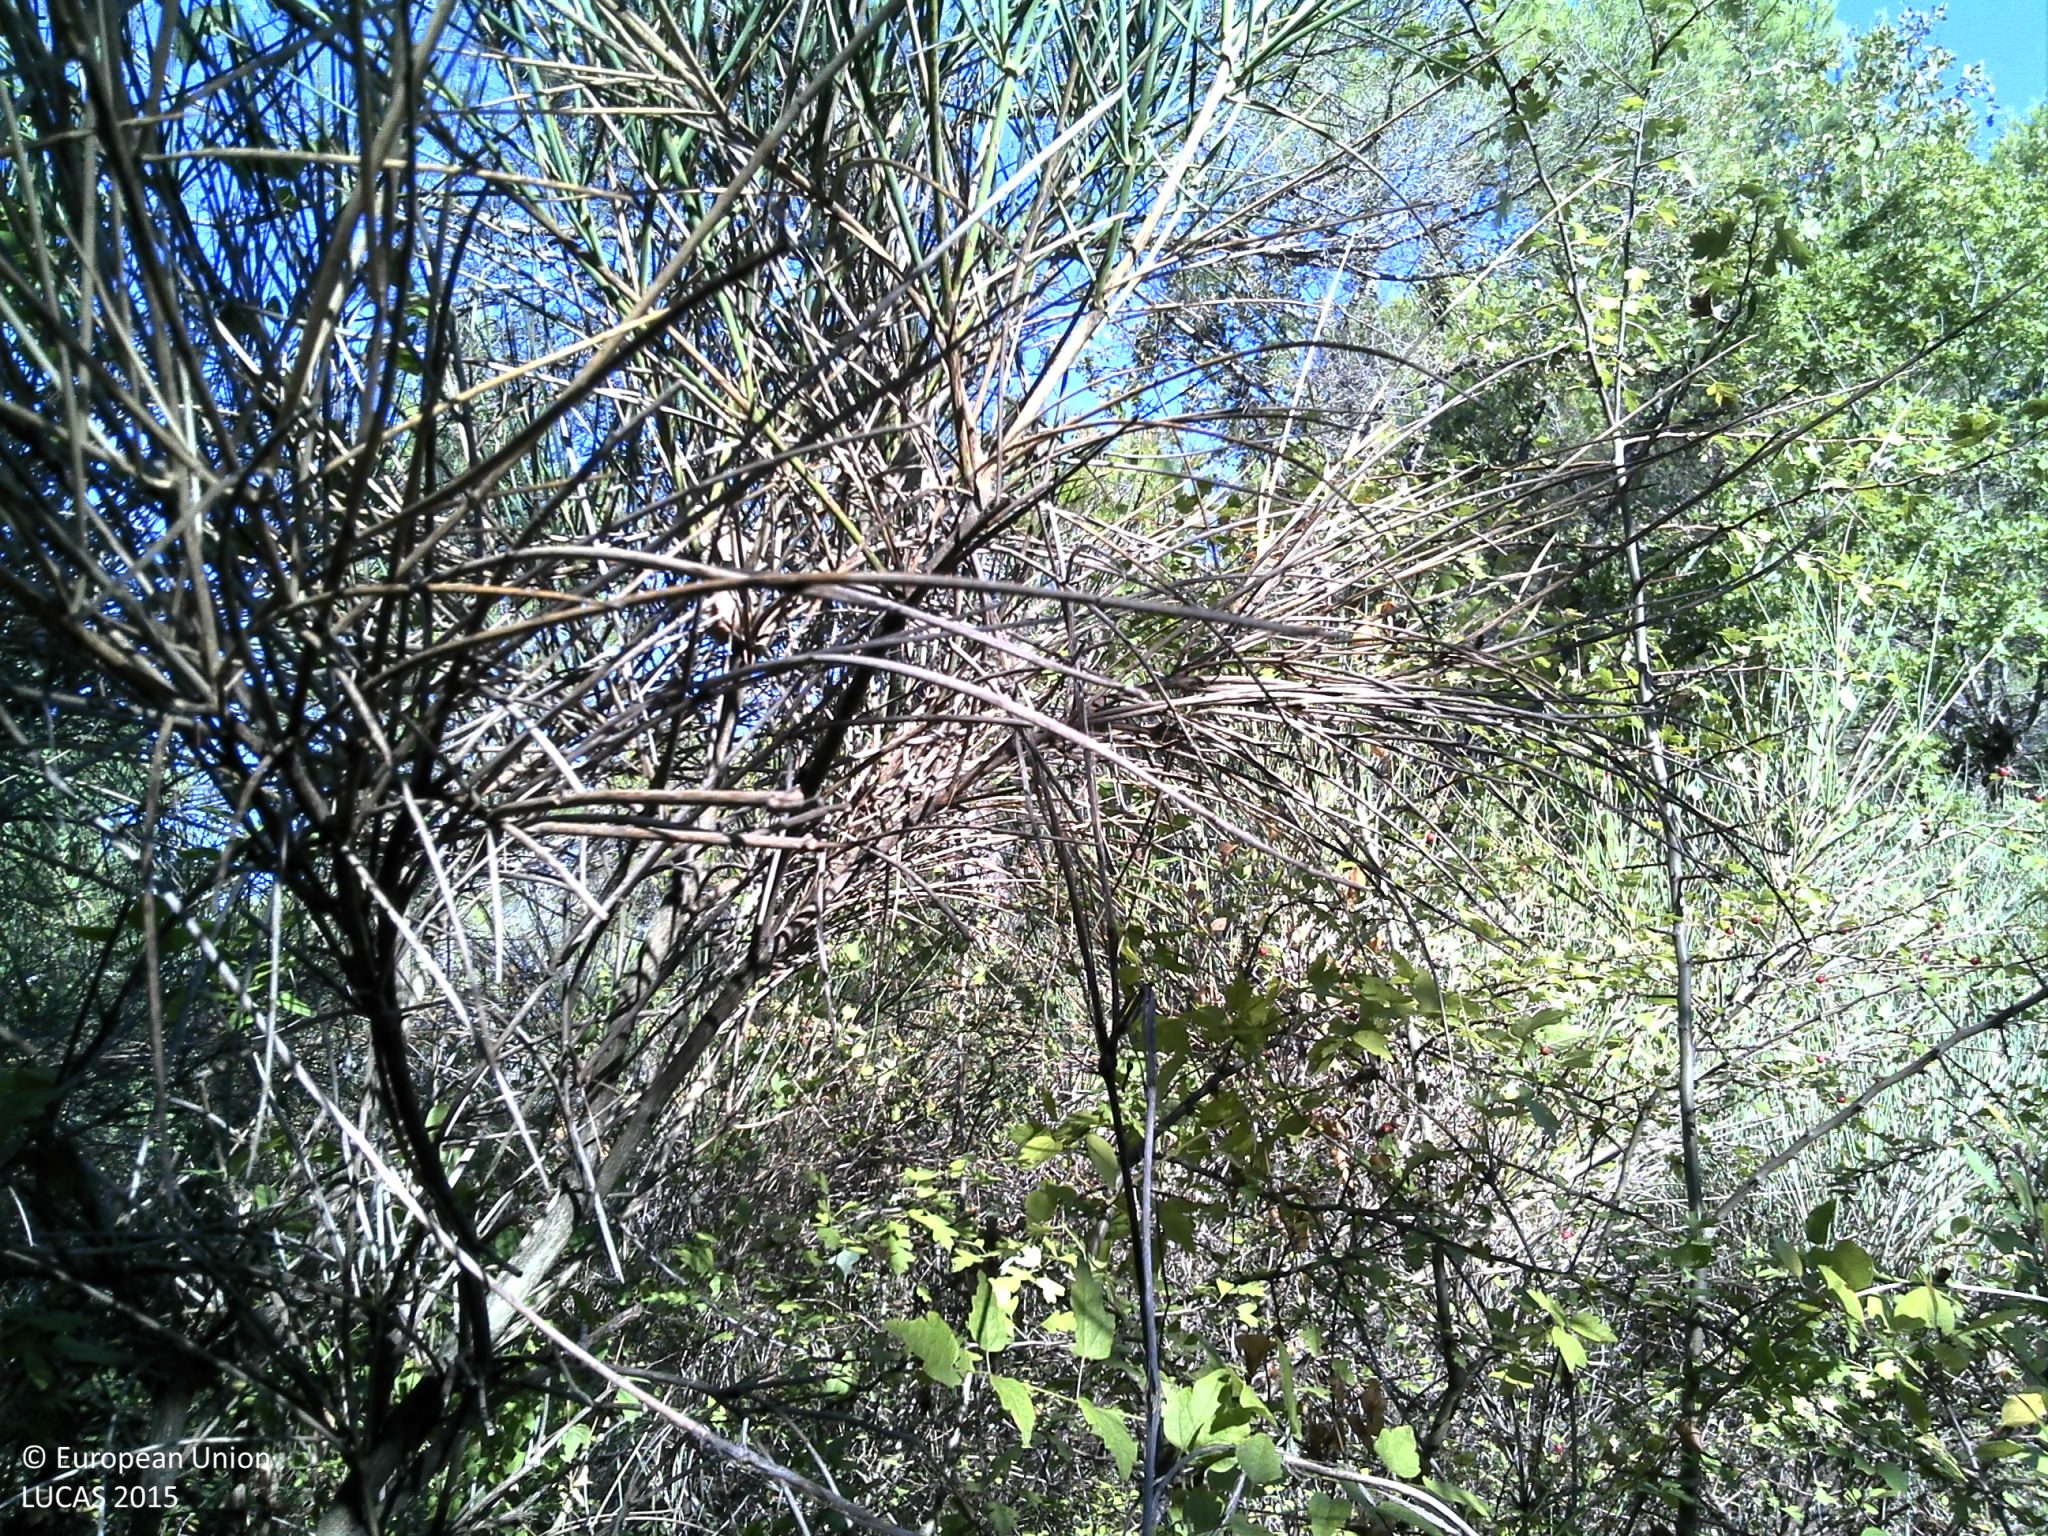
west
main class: Woodland
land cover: Broadleaved woodland
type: thermophilous deciduous forest
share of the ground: 50 - 75 %
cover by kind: broadleaved forest trees 70 %, shrubs 20 %, coniferous forest trees 10 %
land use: Forestry
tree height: > 5 m
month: September
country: FR
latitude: 43.7864
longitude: 5.5726
